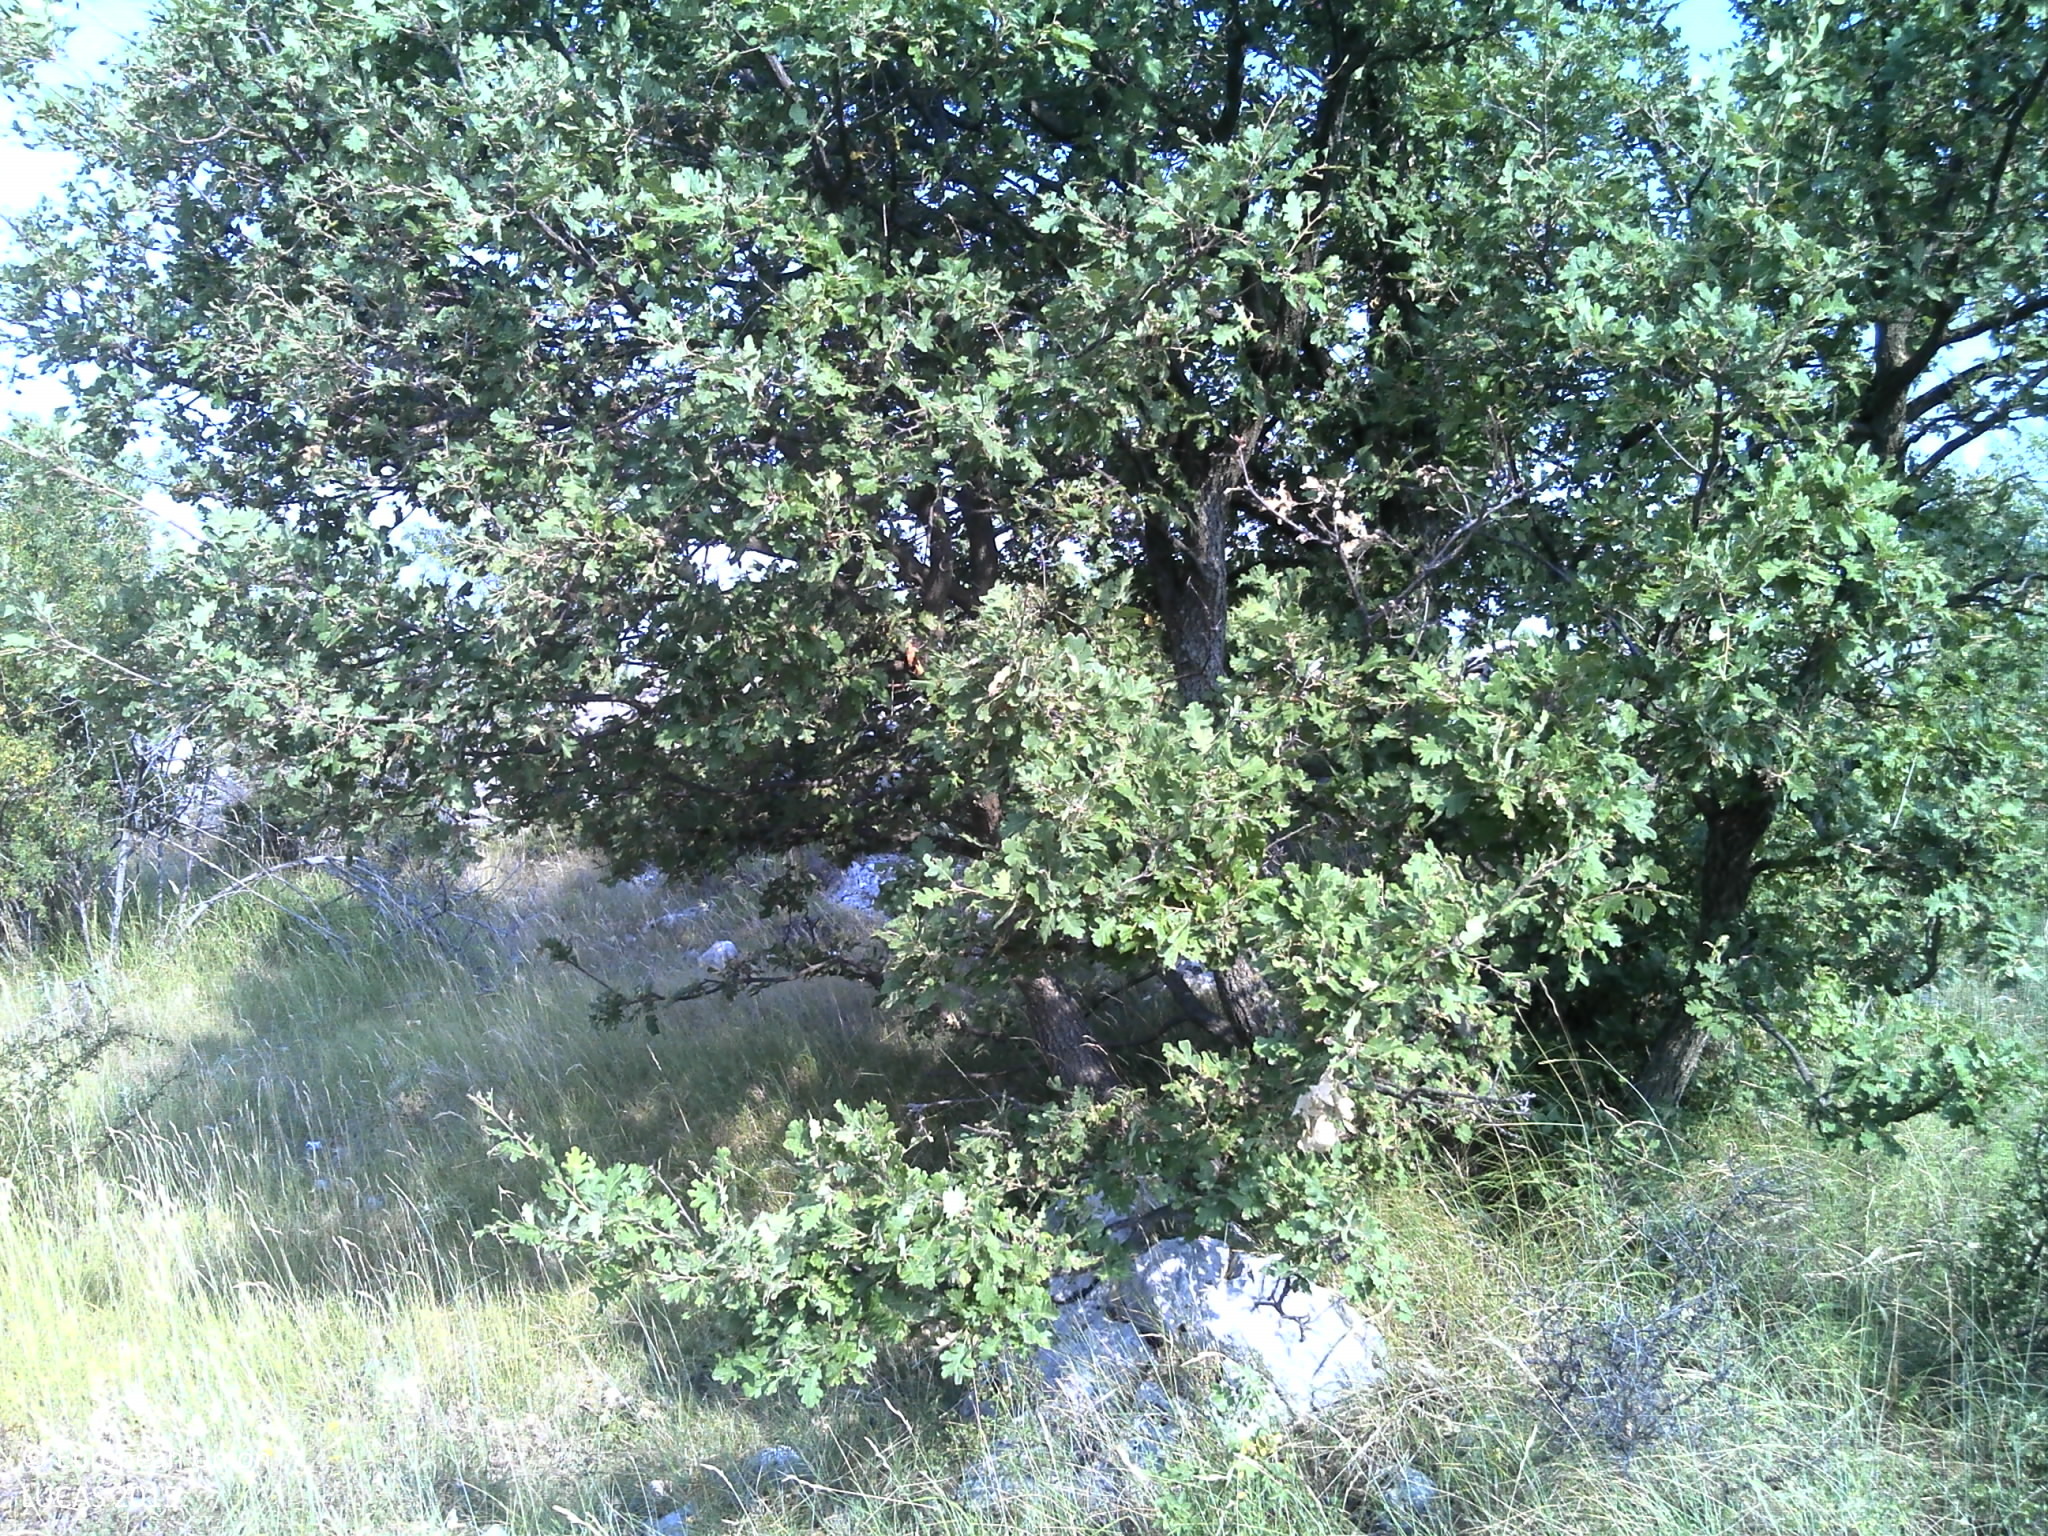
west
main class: Grassland
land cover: Grassland with sparse tree/shrub cover
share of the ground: > 75 %
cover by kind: herbaceous plants 70 %, shrubs 10 %, broadleaved forest trees 5 %, lichens and mosses 5 %, consolidated bare surface 5 %, unconsolidated bare surface 5 %
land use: Abandoned areas
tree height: > 5 m
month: July
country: HR
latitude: 43.4674
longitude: 16.9258
